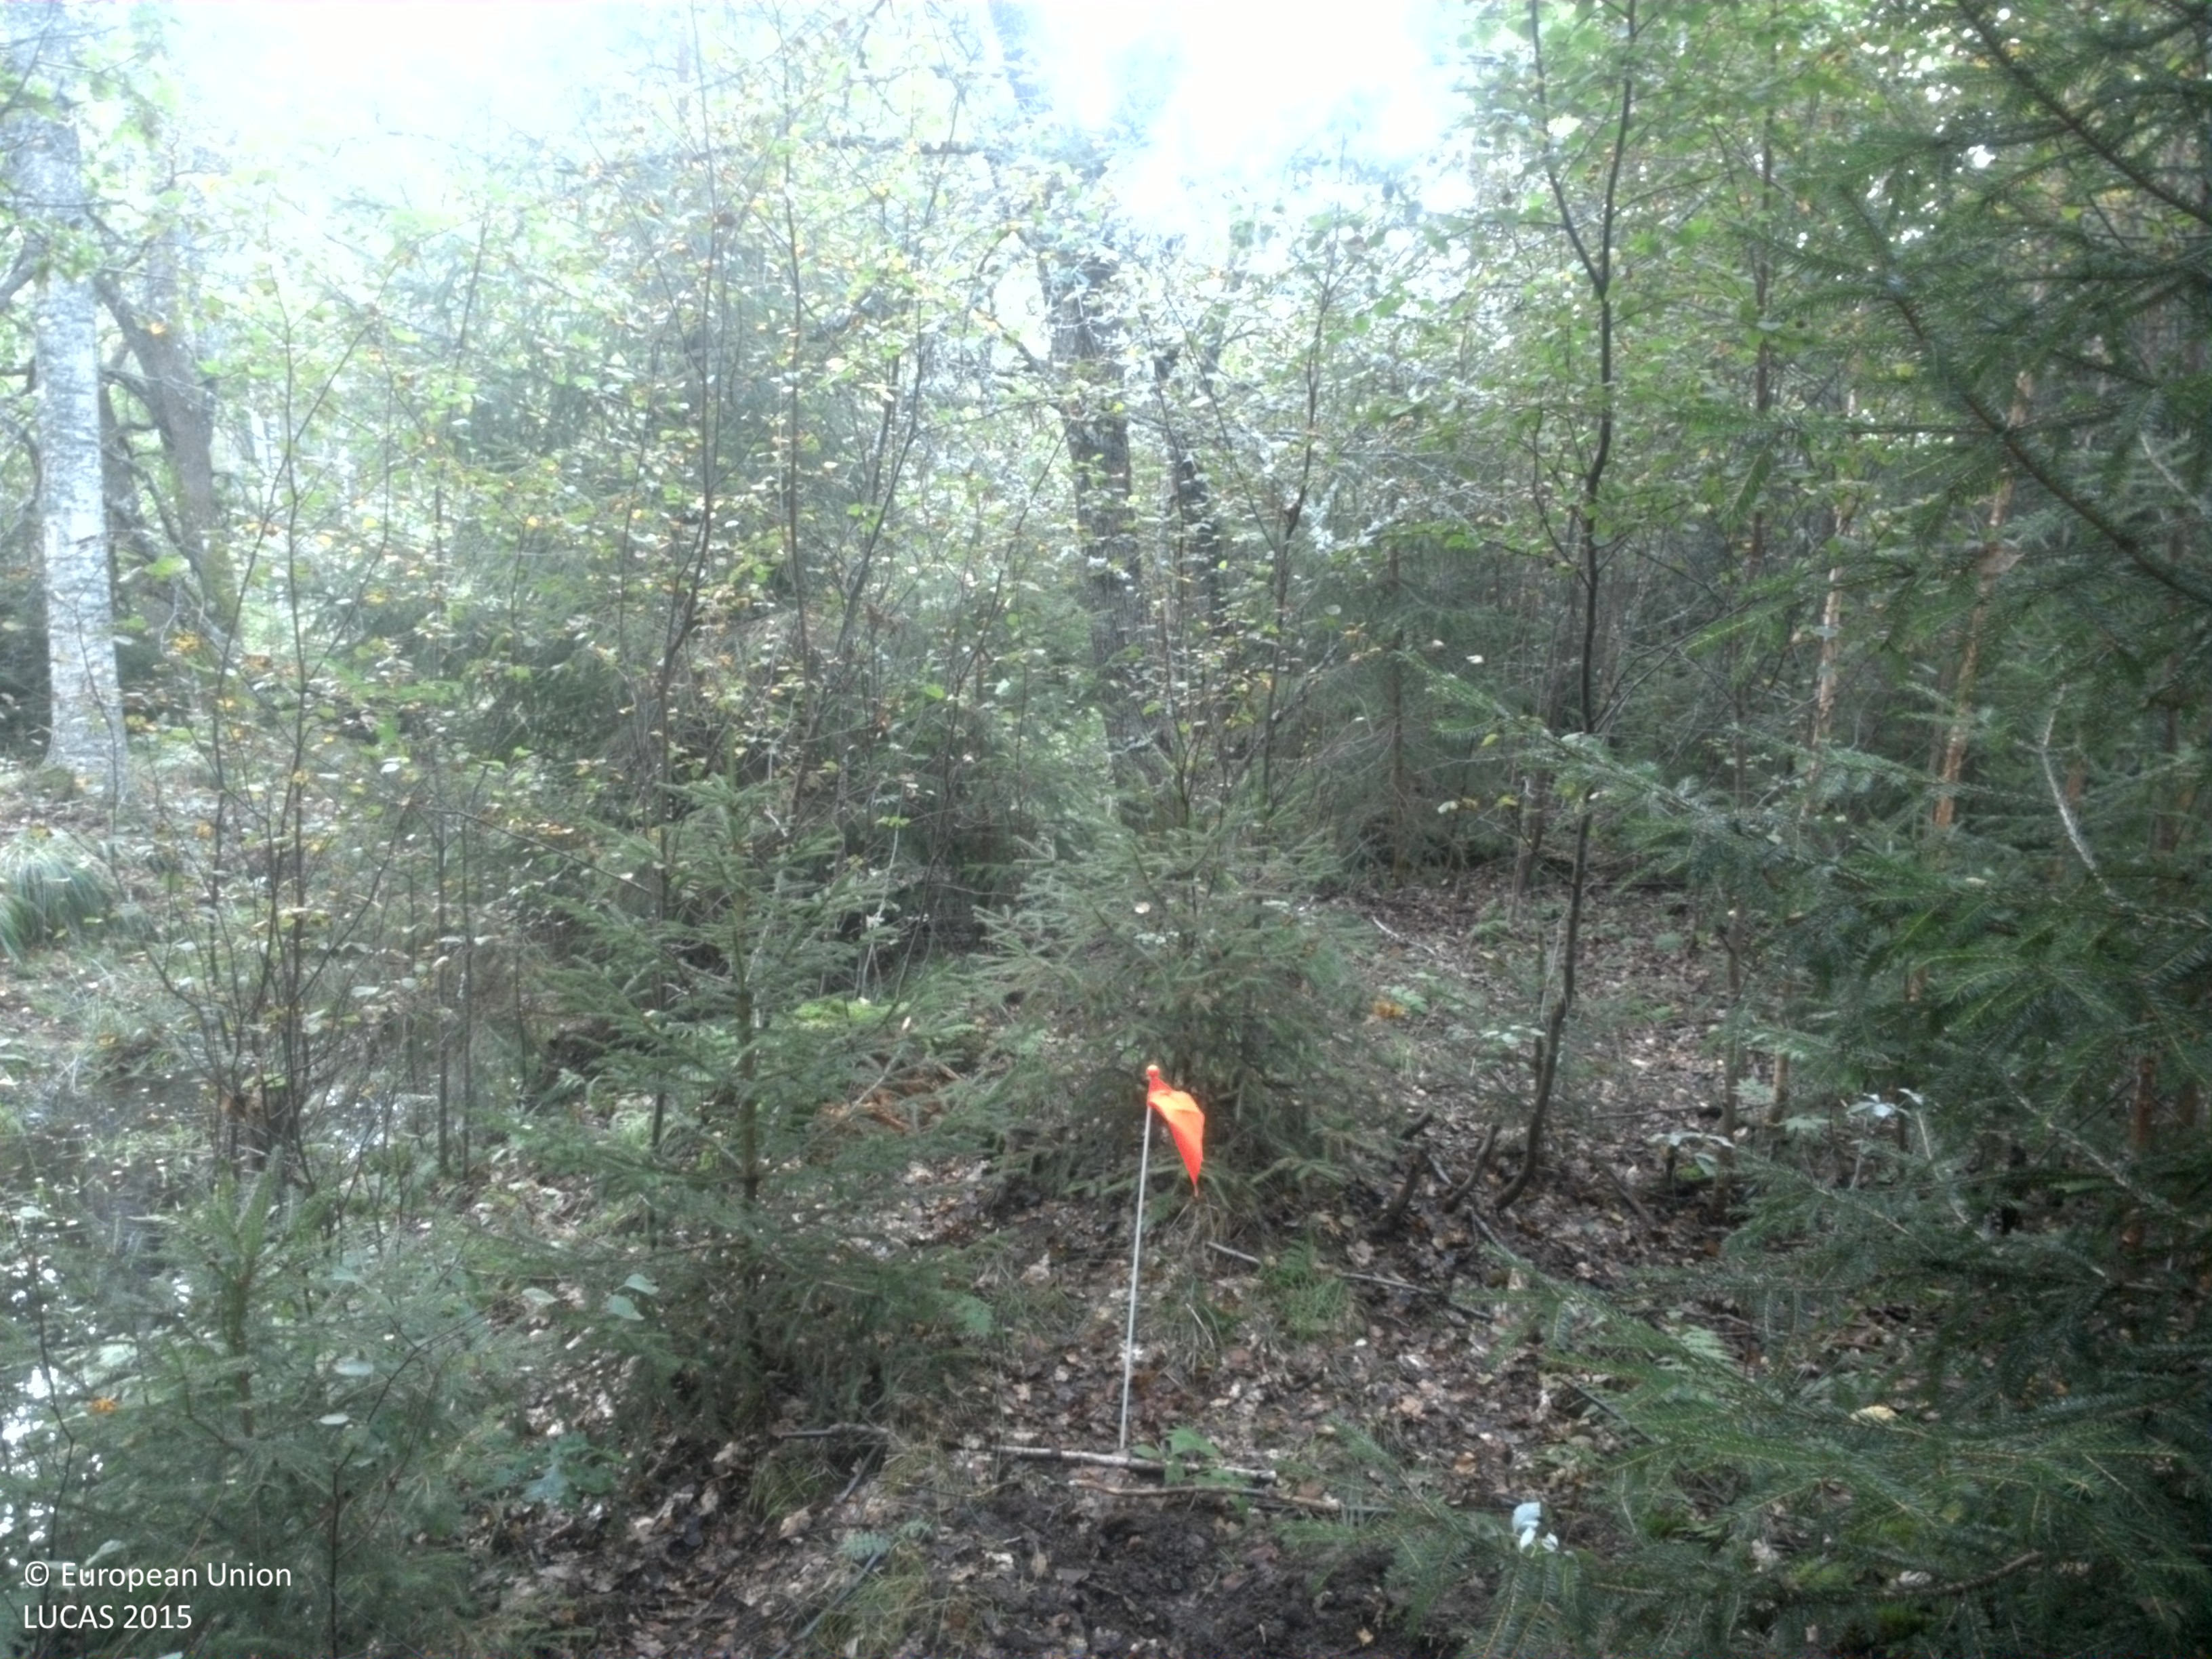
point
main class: Woodland
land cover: Spruce dominated mixed woodland
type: boreal forest
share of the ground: > 75 %
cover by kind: broadleaved forest trees 50 %, coniferous forest trees 25 %, unconsolidated bare surface 10 %, shrubs 5 %, herbaceous plants 5 %
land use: Forestry
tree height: > 5 m
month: September
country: SE
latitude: 59.5569
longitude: 15.7771
